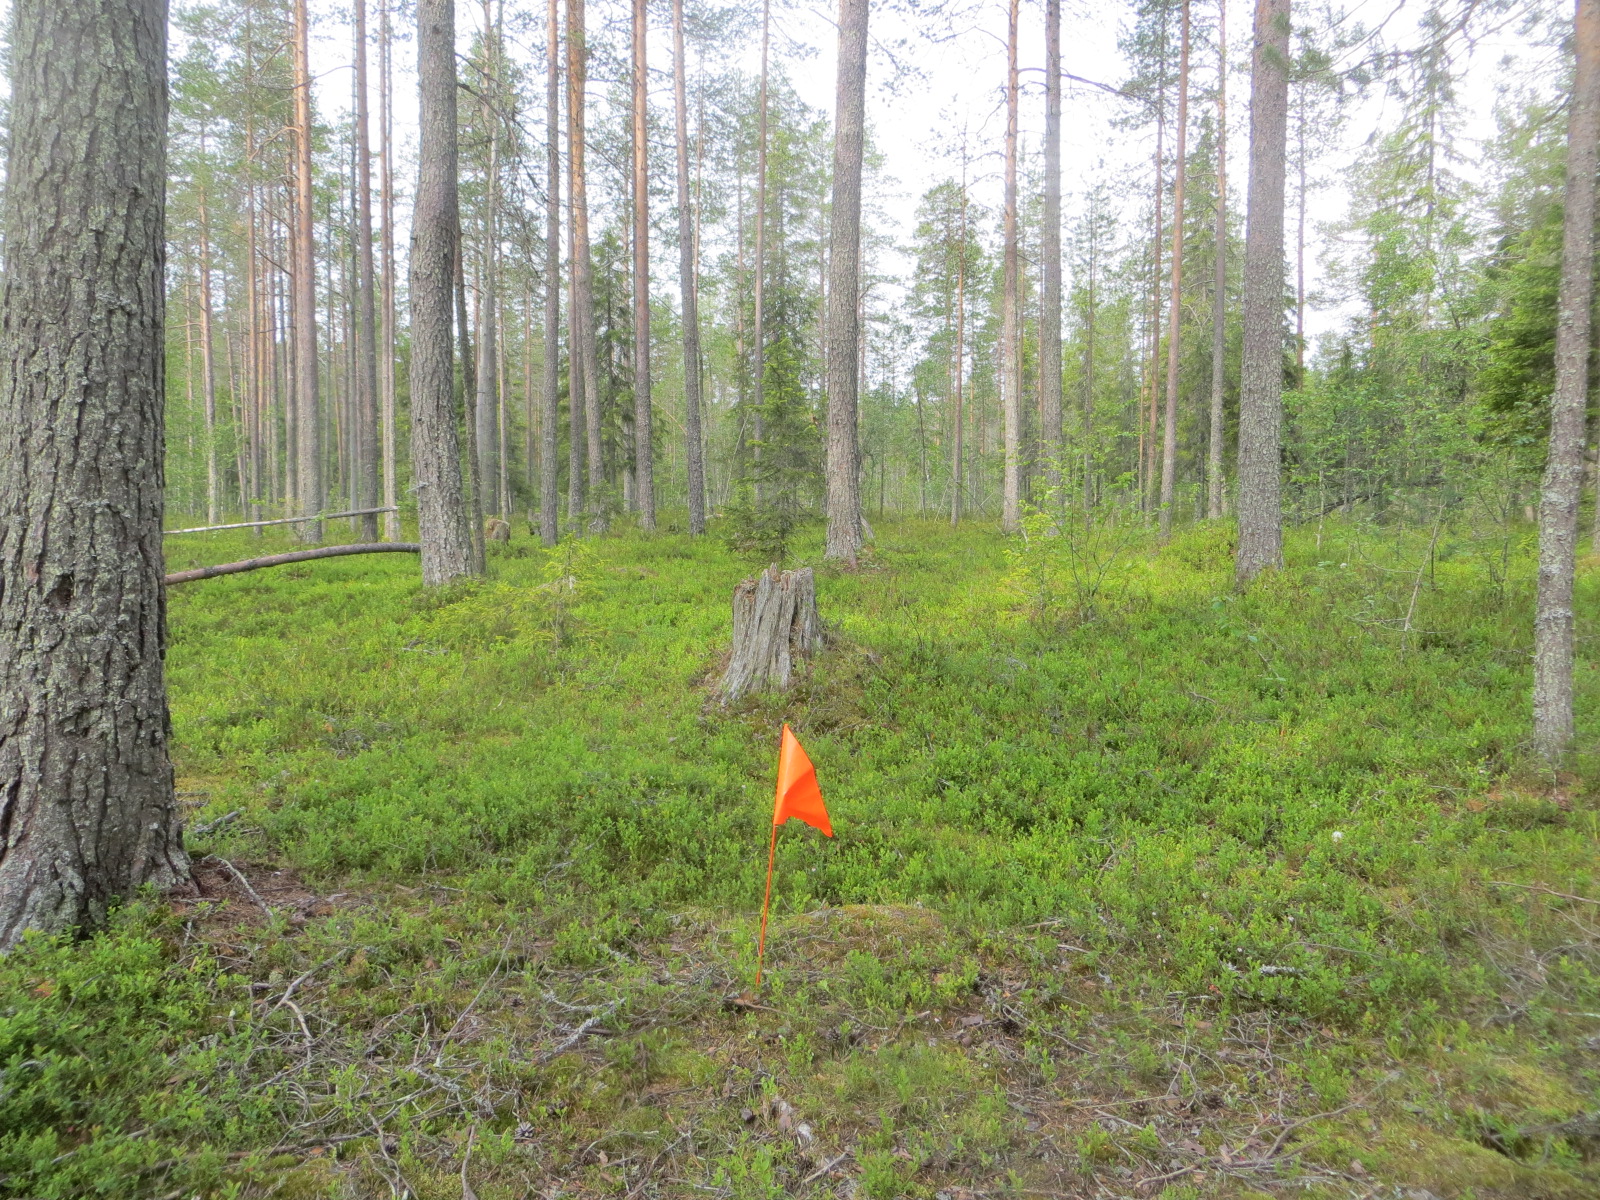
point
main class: Woodland
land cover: Pine dominated coniferous woodland
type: boreal forest
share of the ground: 50 - 75 %
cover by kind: coniferous forest trees 50 %, shrubs 45 %, broadleaved forest trees 5 %
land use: Forestry
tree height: > 5 m
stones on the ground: 25 - 50 %
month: July
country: FI
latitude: 66.3315
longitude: 25.9024
